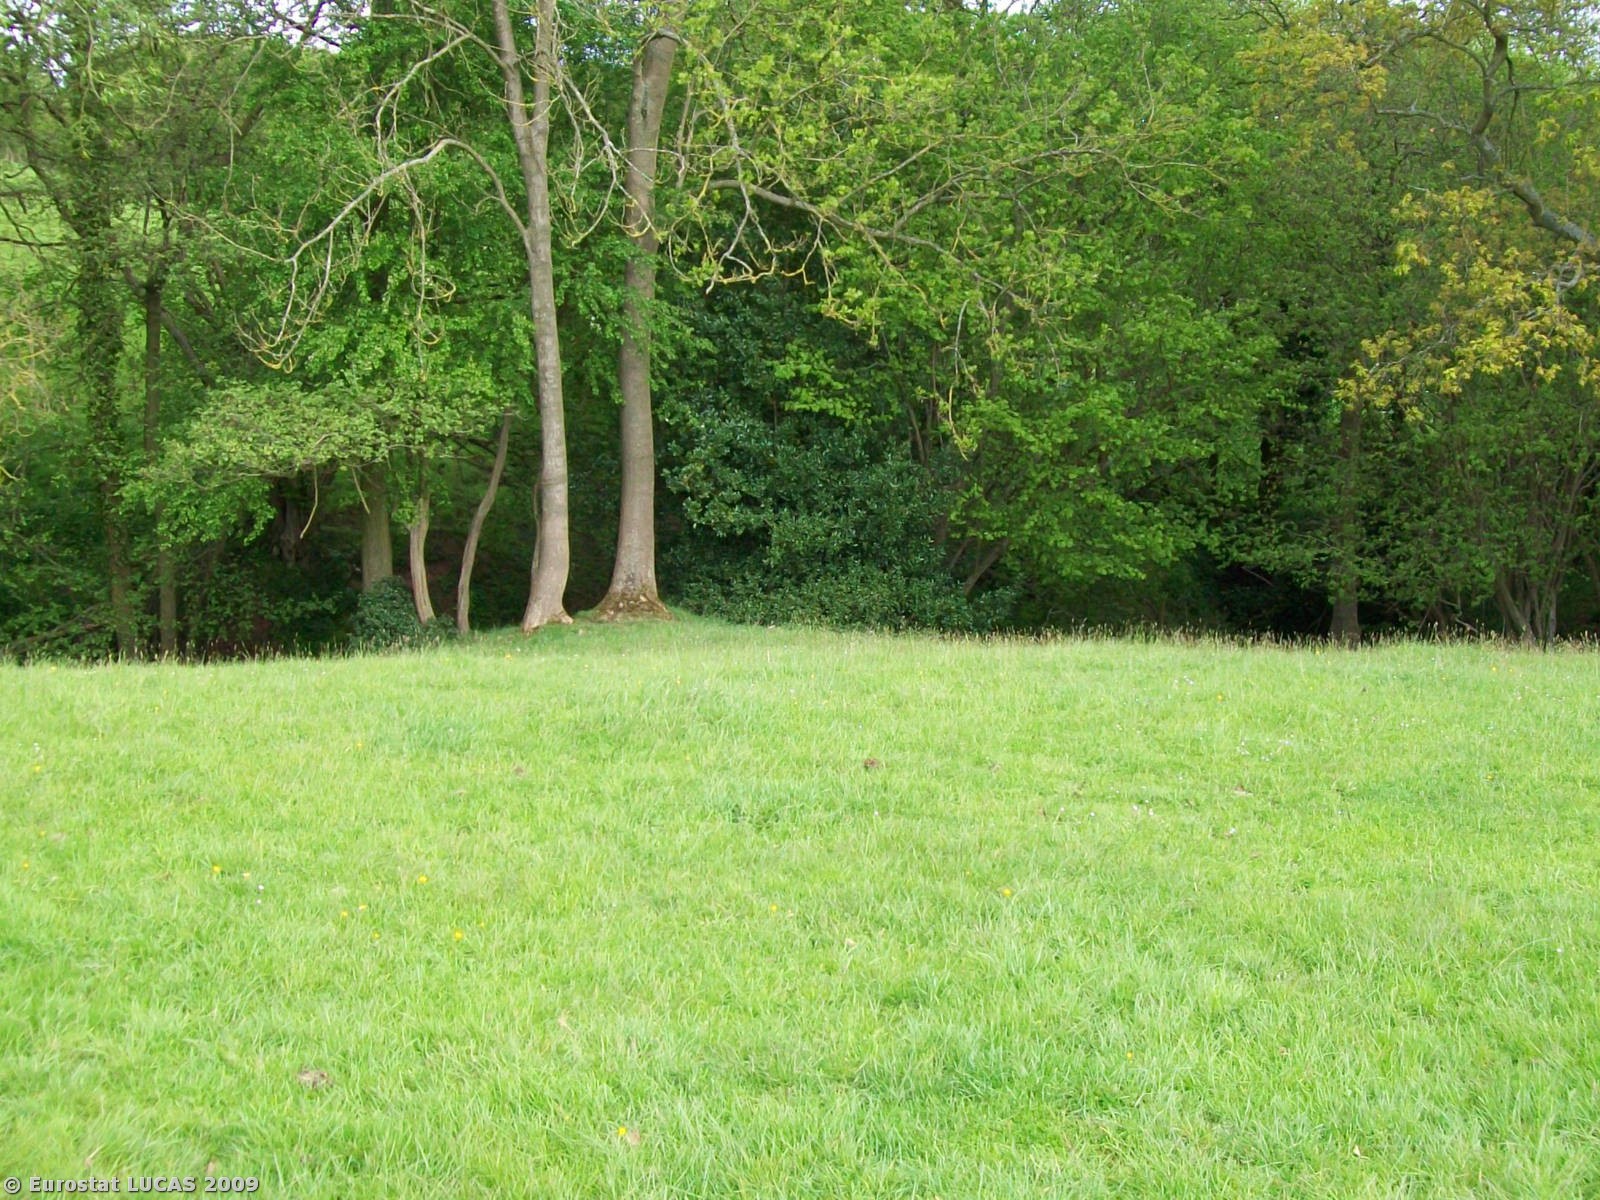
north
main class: Grassland
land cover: Grassland without tree/shrub cover
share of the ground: > 75 %
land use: Agriculture (excluding fallow land and kitchen gardens)
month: May
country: GB
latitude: 52.2974
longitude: -2.4860
